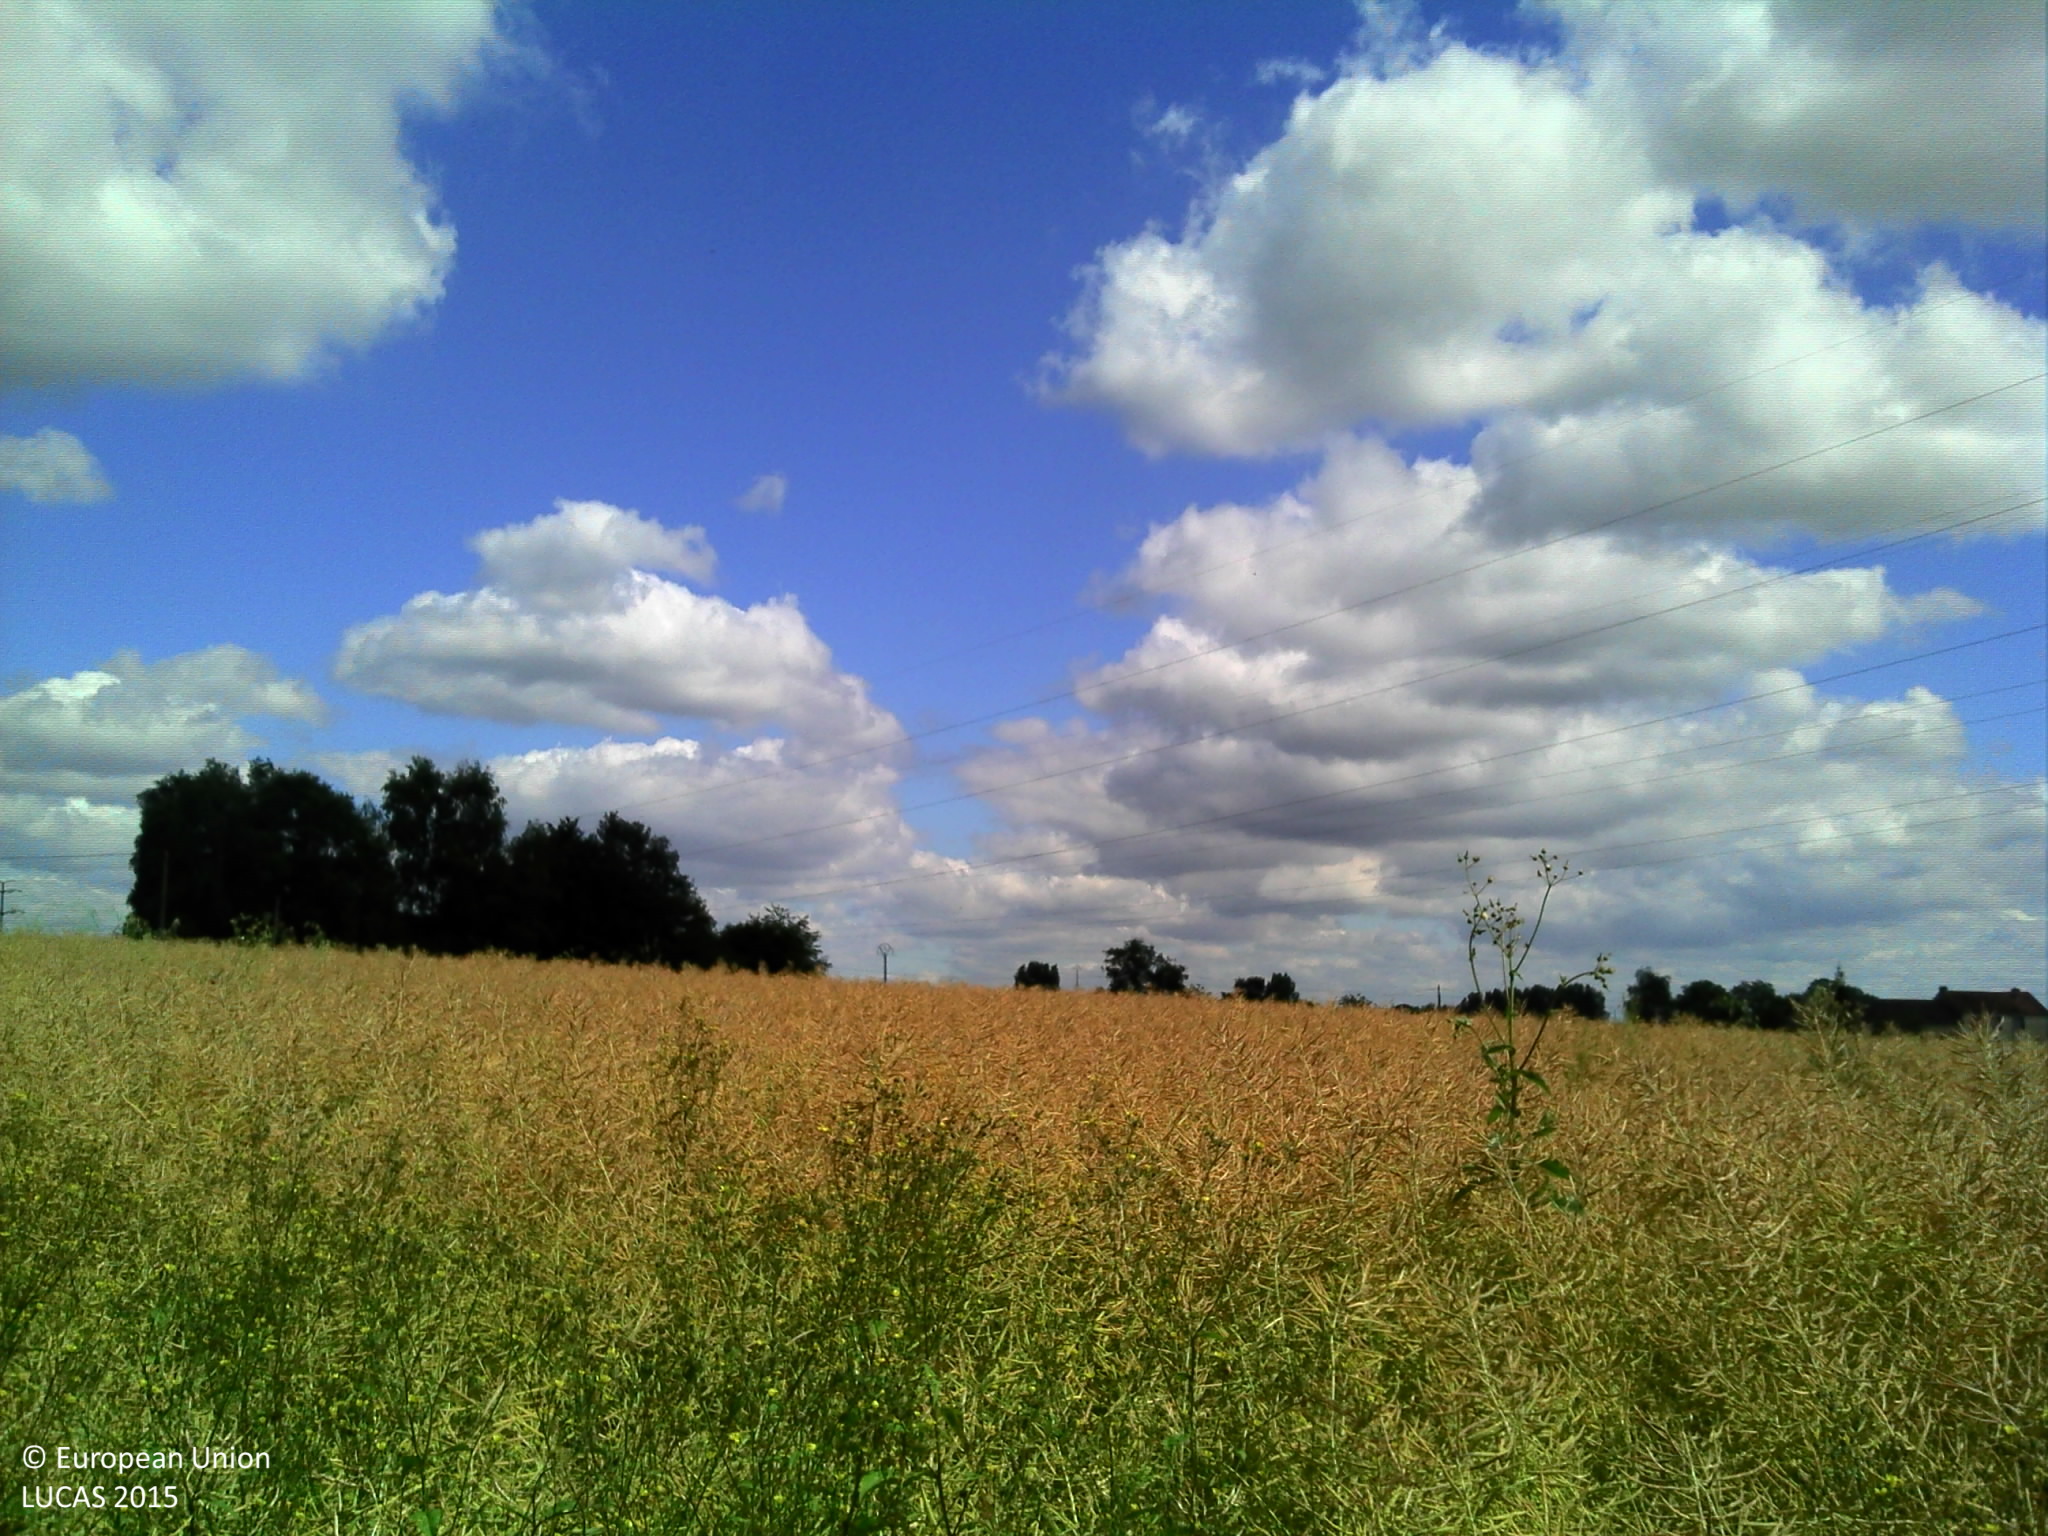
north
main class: Cropland
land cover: Rape and turnip rape
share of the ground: > 75 %
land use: Agriculture (excluding fallow land and kitchen gardens)
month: June
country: FR
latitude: 47.8813
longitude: 0.2534
